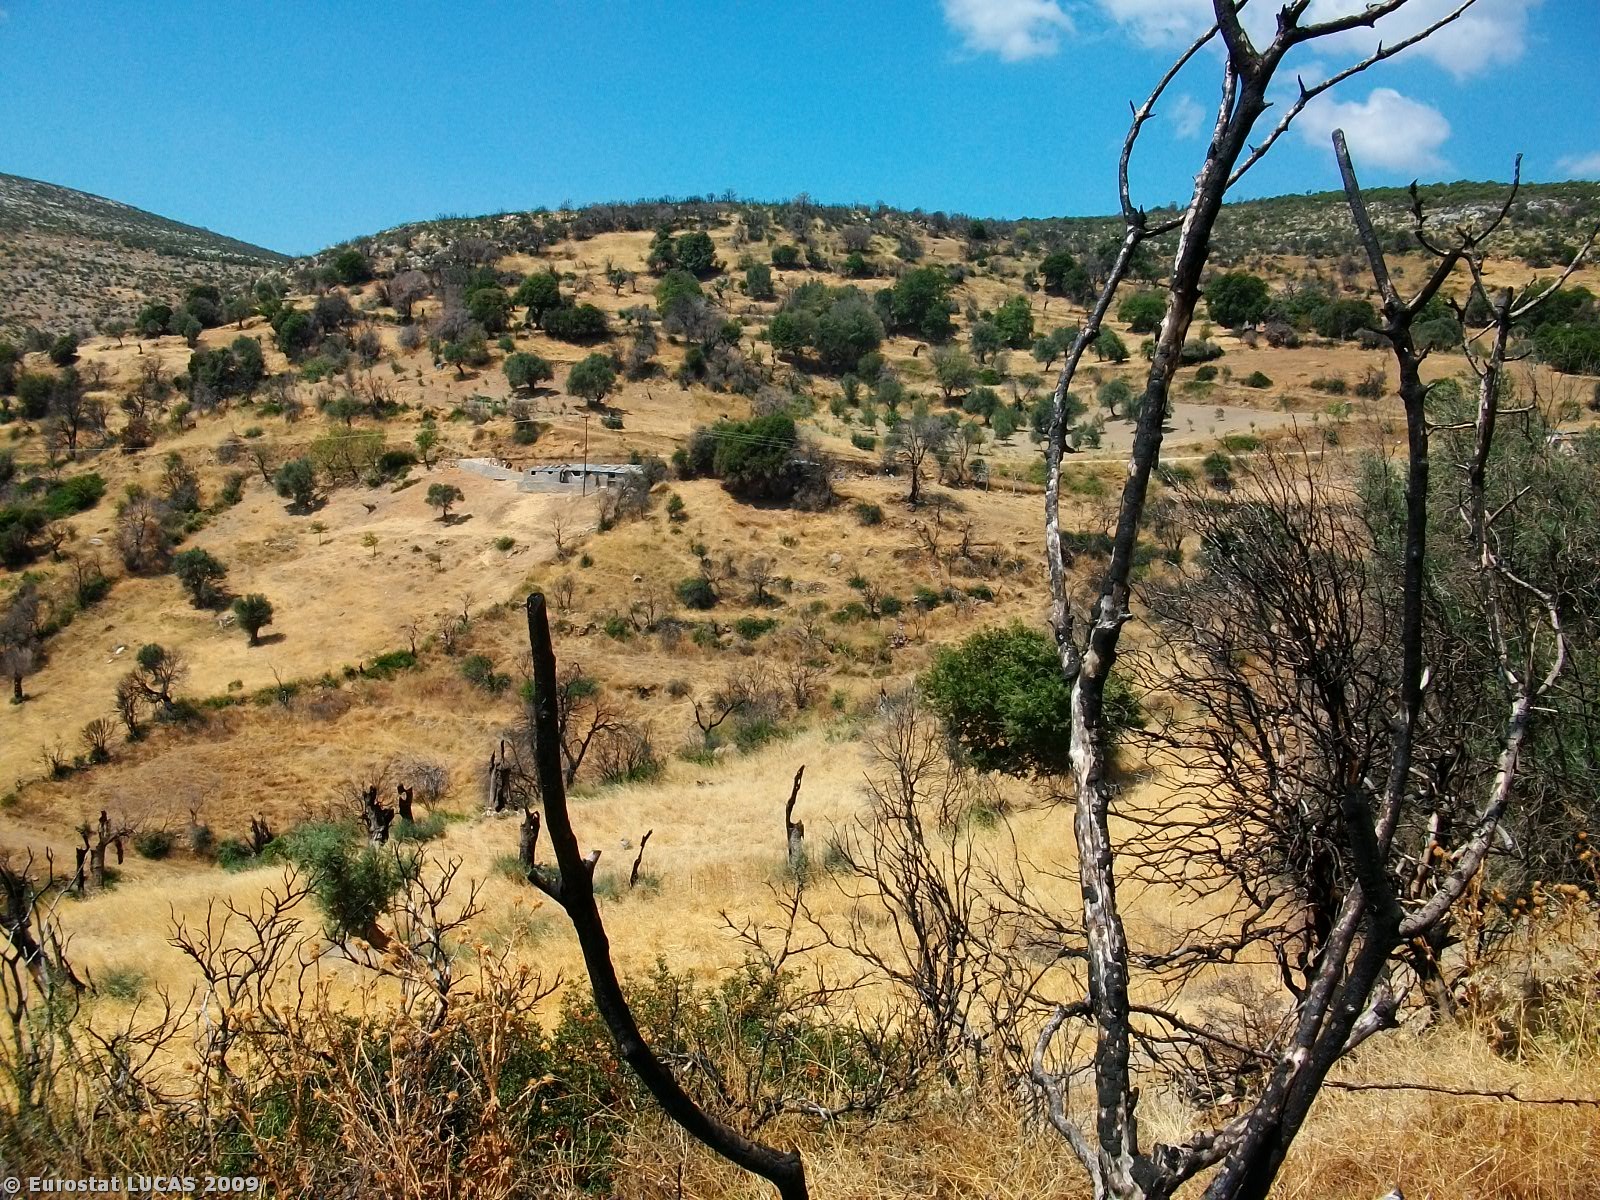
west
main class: Grassland
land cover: Grassland with sparse tree/shrub cover
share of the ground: > 75 %
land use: Unused
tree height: < 5 m
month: August
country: GR
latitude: 38.4925
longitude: 23.9668
